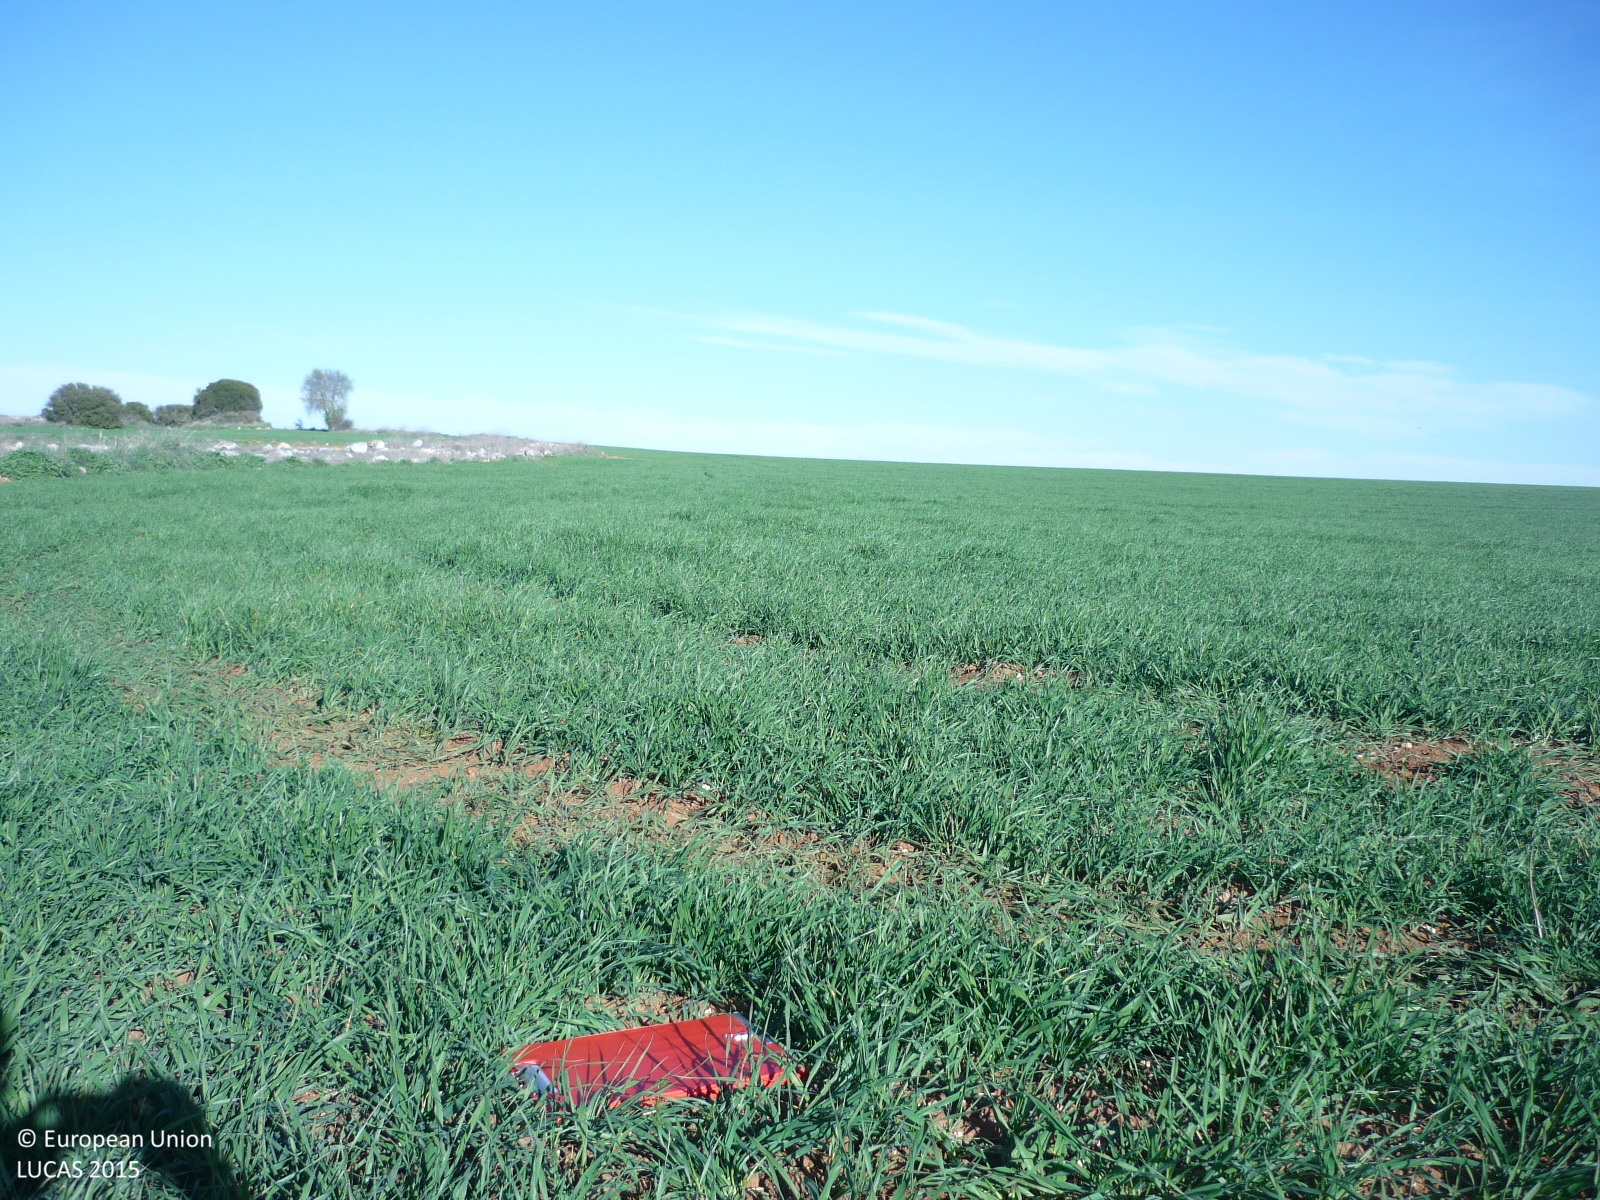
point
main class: Cropland
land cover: Barley
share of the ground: 50 - 75 %
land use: Agriculture (excluding fallow land and kitchen gardens)
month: March
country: ES
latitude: 40.3638
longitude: -3.3033
